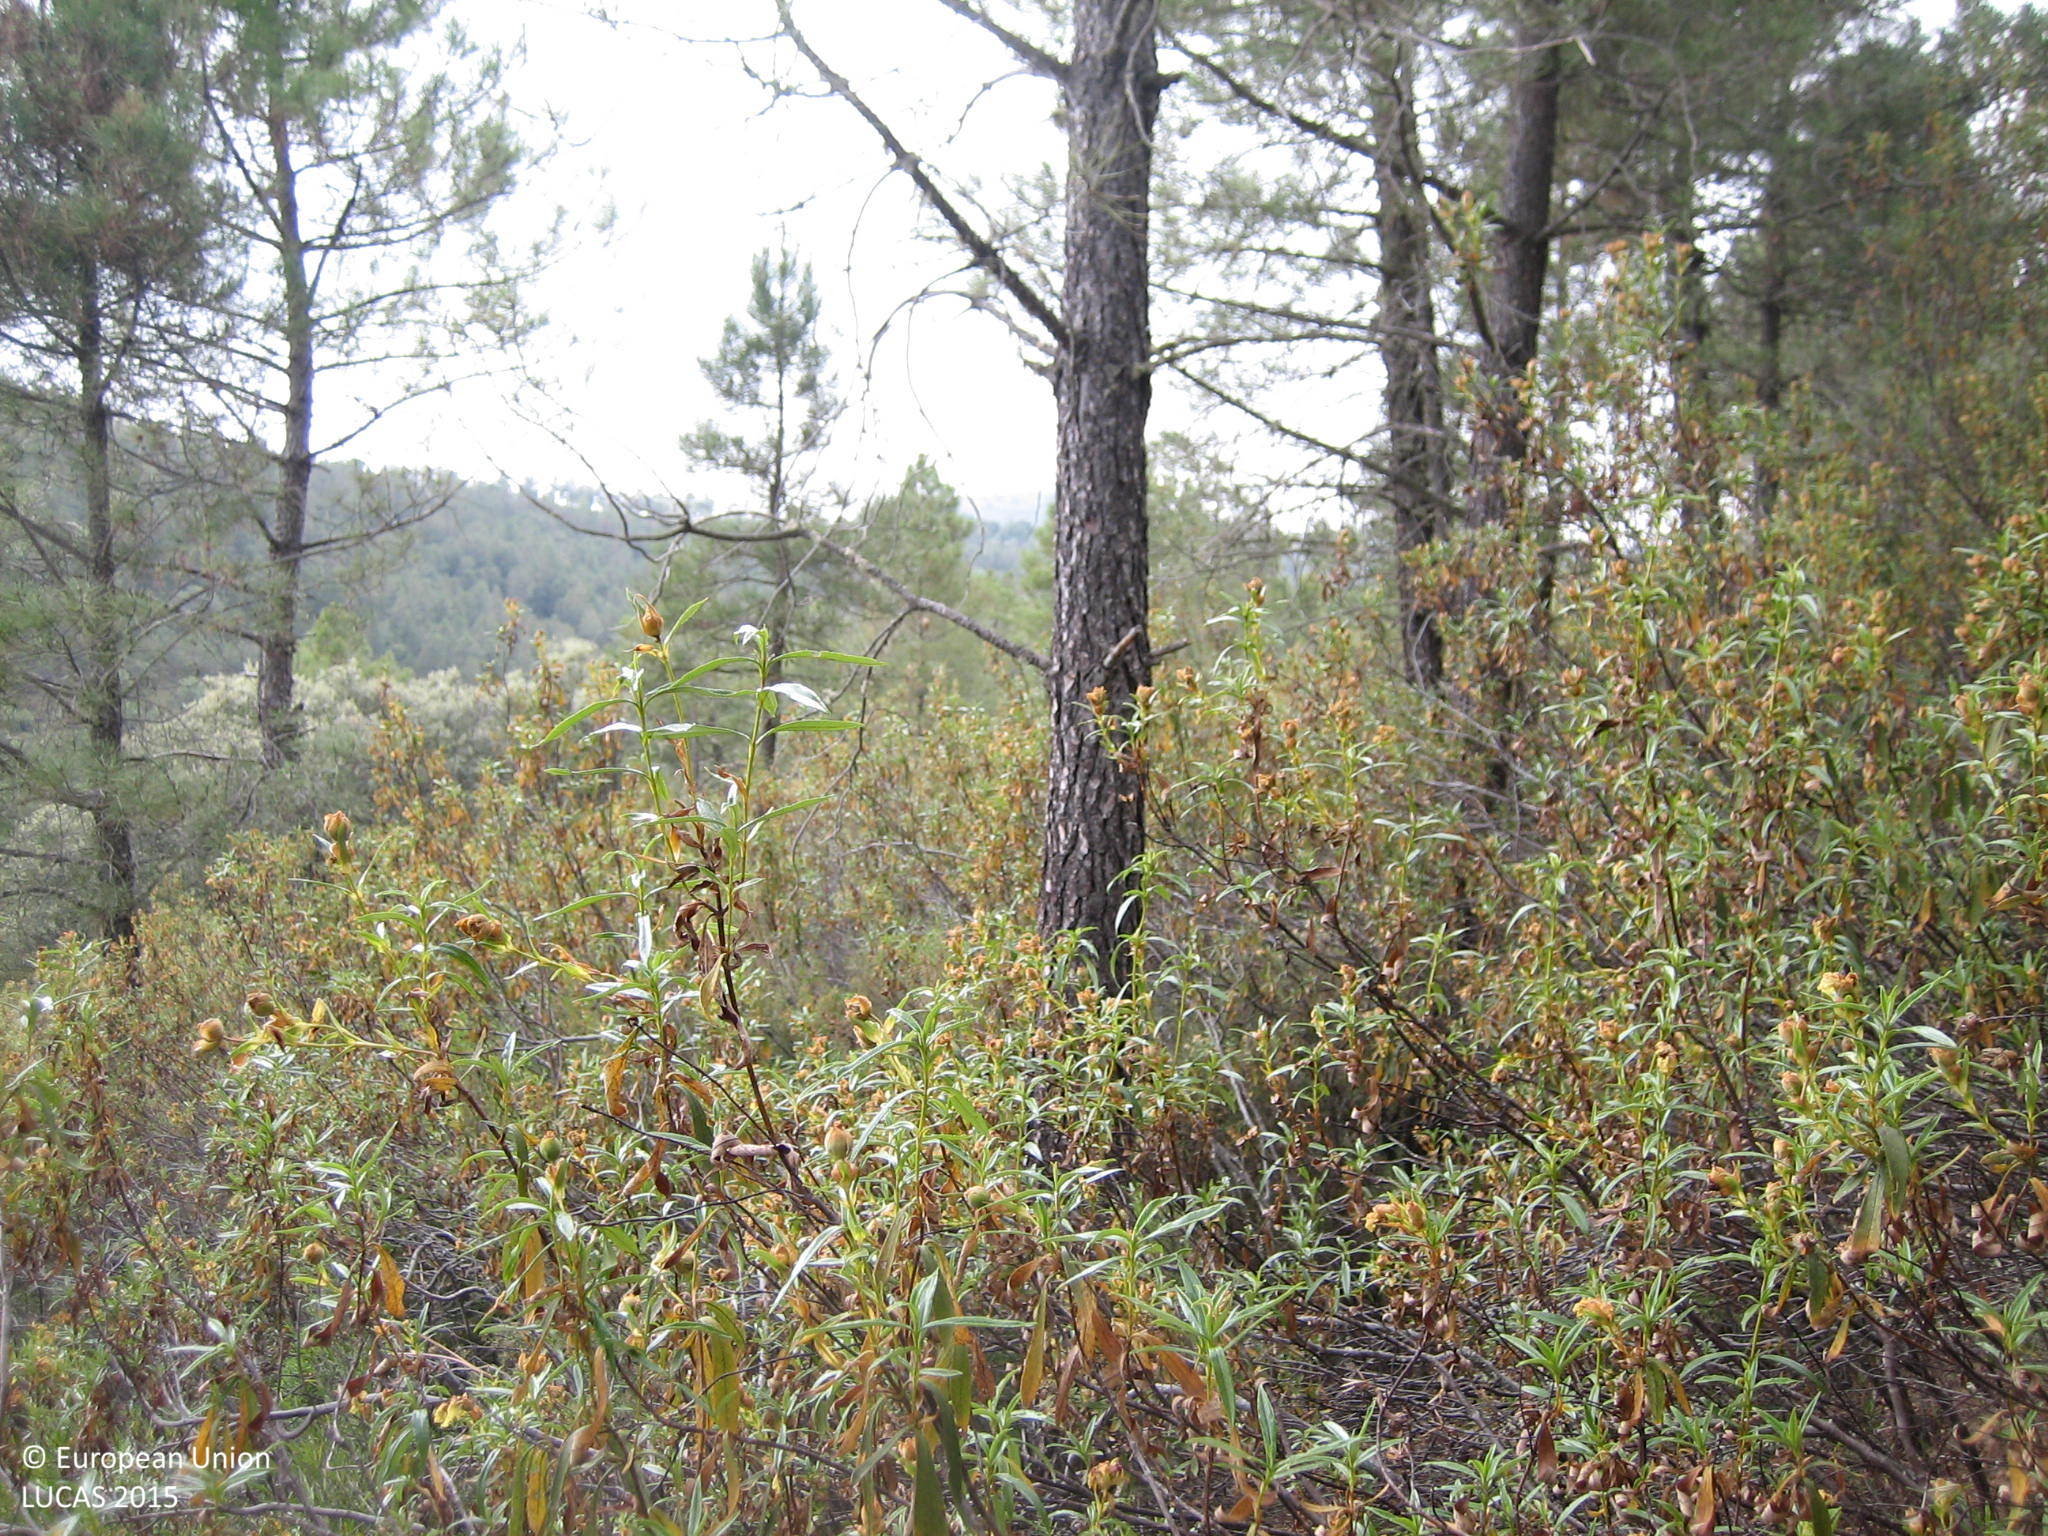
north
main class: Shrubland
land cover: Shrubland with sparse tree cover
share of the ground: > 75 %
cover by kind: shrubs 95 %, broadleaved forest trees 5 %
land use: Semi-natural and natural areas not in use
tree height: < 5 m
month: June
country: ES
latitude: 39.0575
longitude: -4.4856
